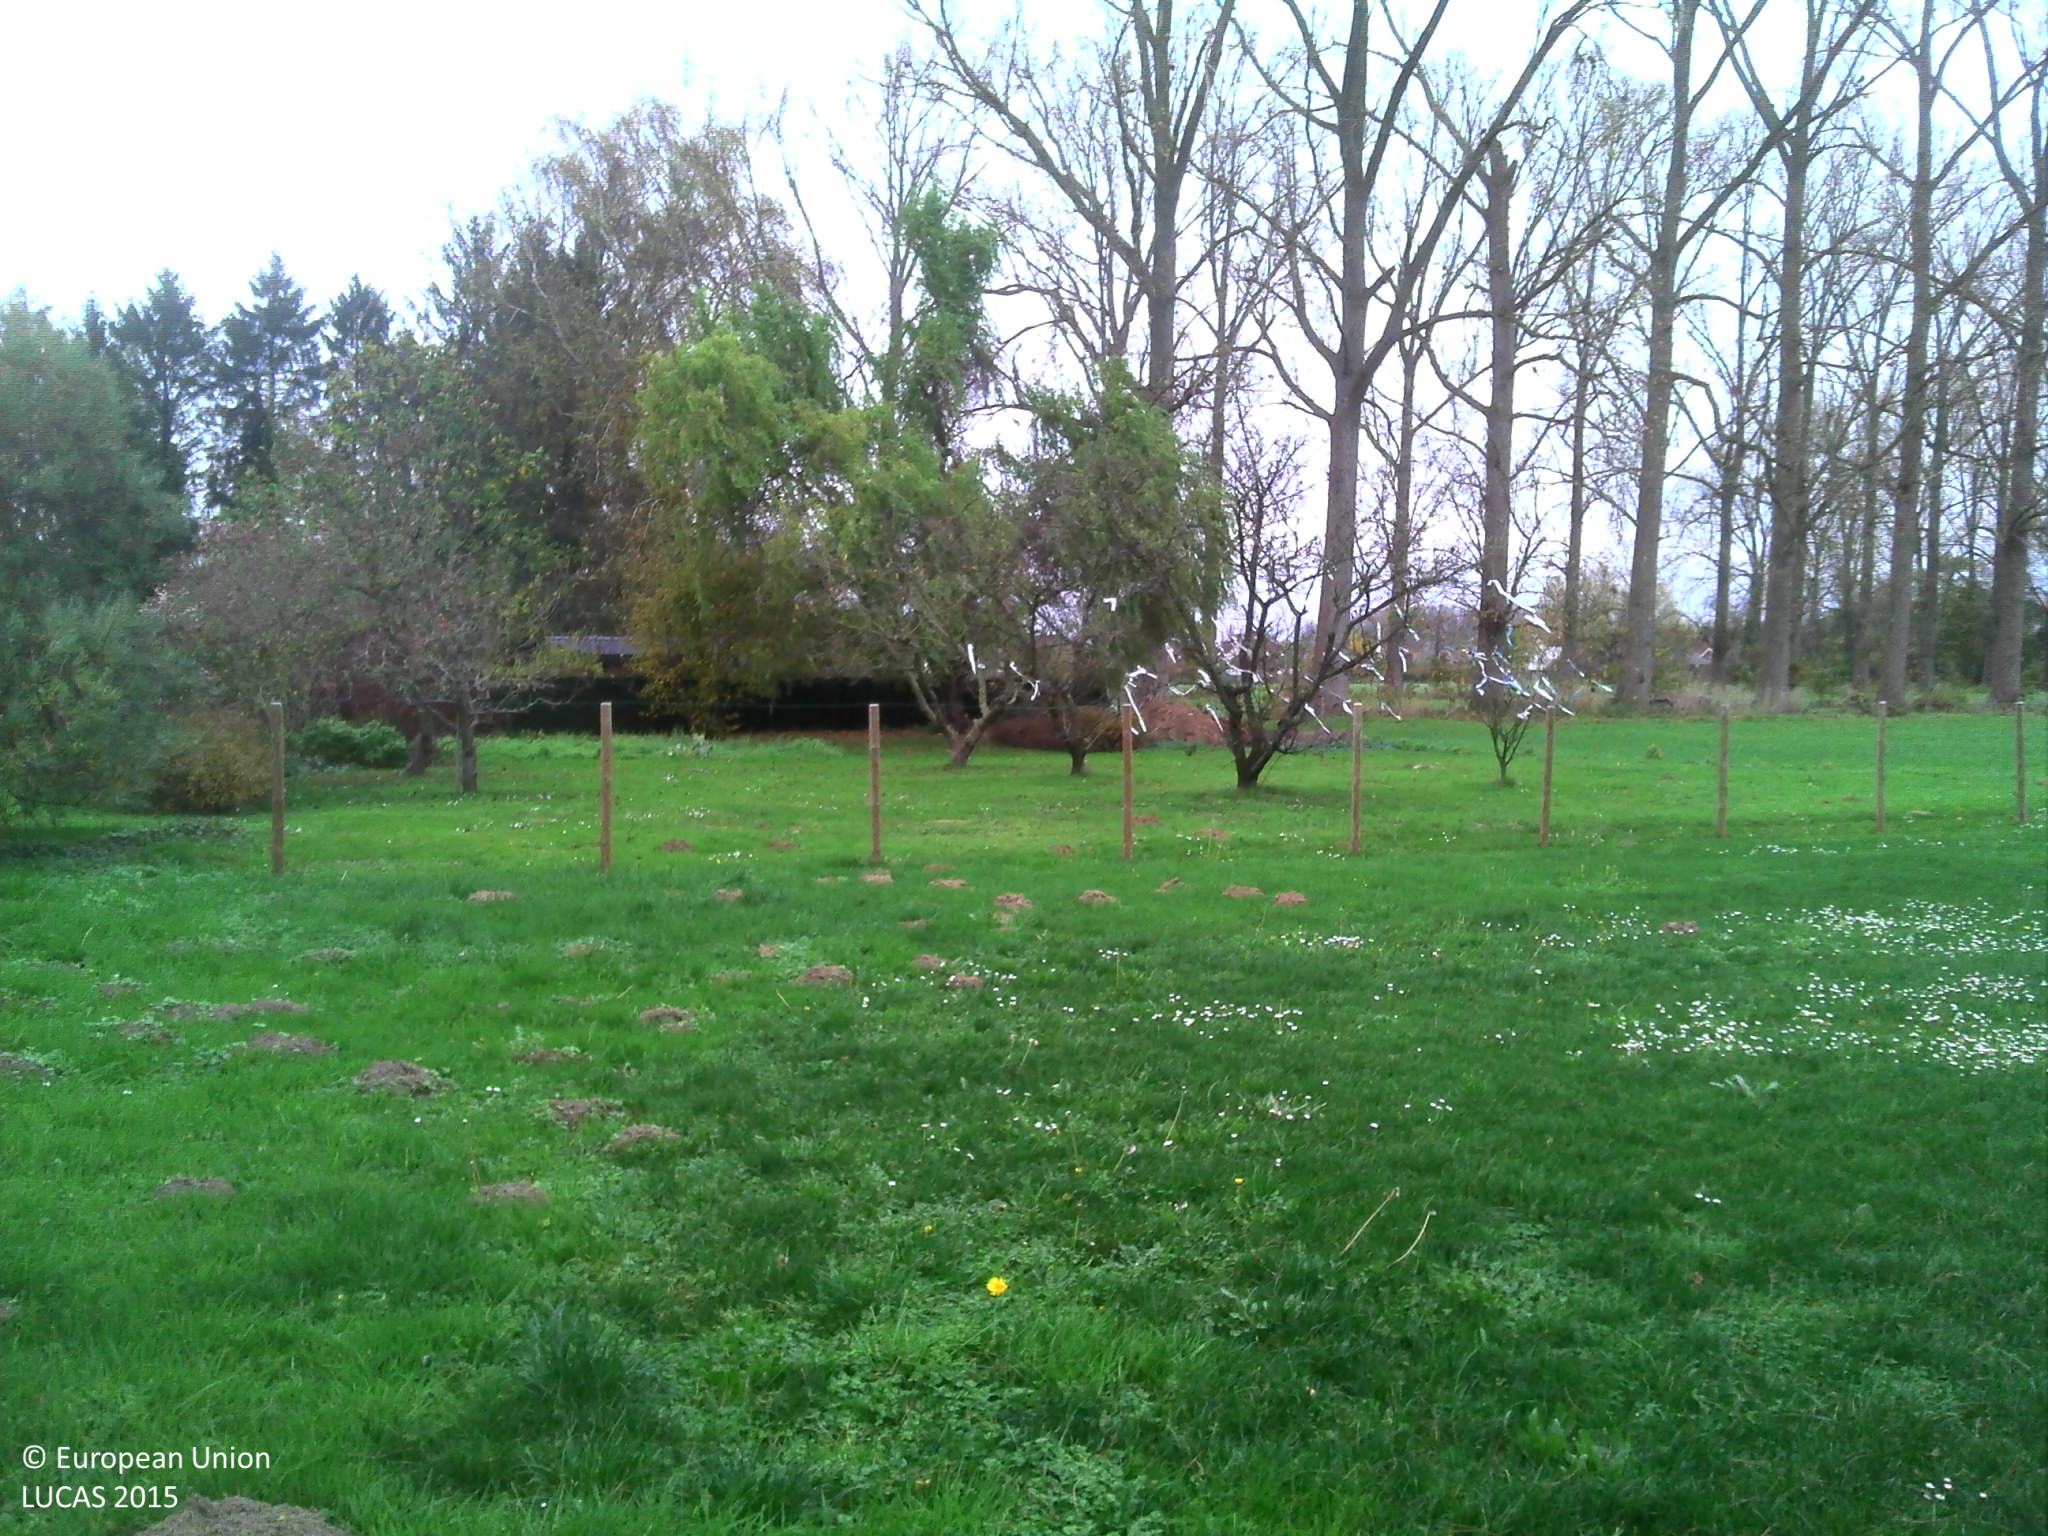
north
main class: Grassland
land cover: Grassland with sparse tree/shrub cover
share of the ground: > 75 %
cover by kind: herbaceous plants 85 %, shrubs 10 %, broadleaved forest trees 5 %
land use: Residential
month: November
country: BE
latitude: 50.9229
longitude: 4.6329
